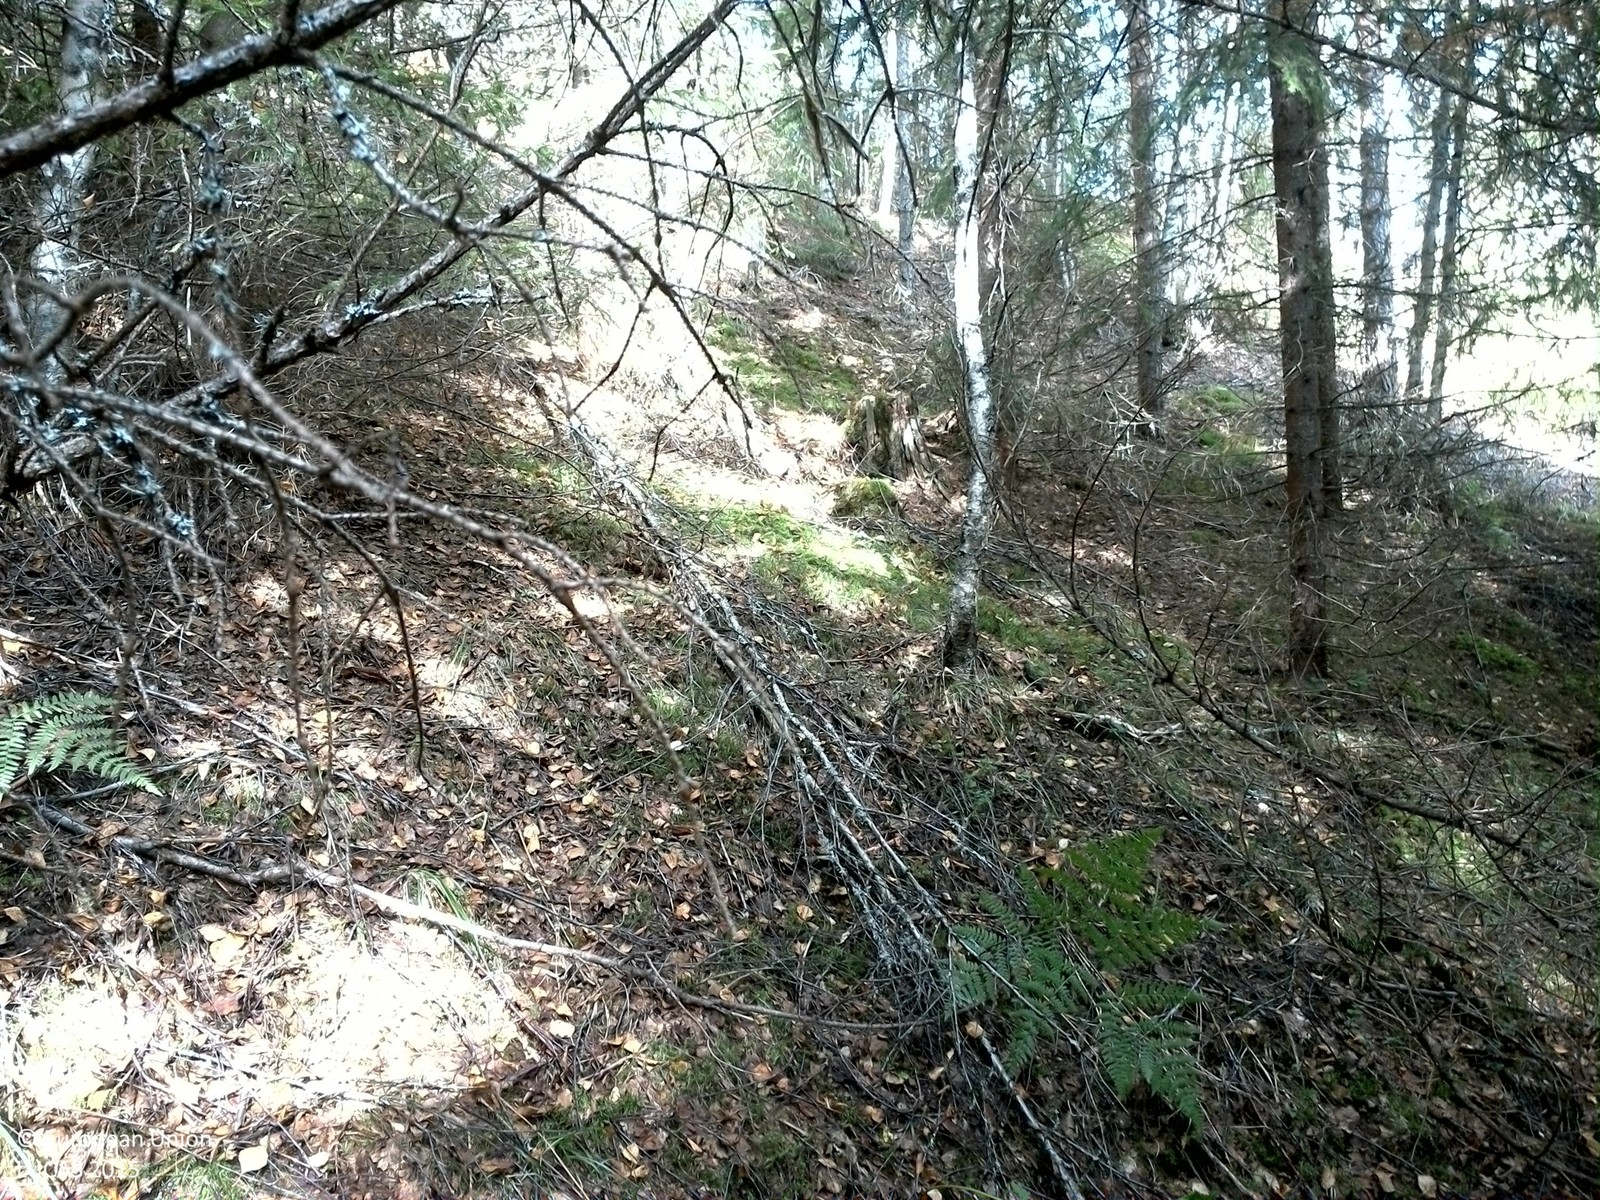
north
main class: Woodland
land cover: Spruce dominated coniferous woodland
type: boreal forest
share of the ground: 50 - 75 %
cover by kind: coniferous forest trees 60 %, lichens and mosses 20 %, broadleaved forest trees 10 %, shrubs 5 %, herbaceous plants 5 %
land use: Forestry
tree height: > 5 m
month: September
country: SE
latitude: 59.9566
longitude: 13.5185
